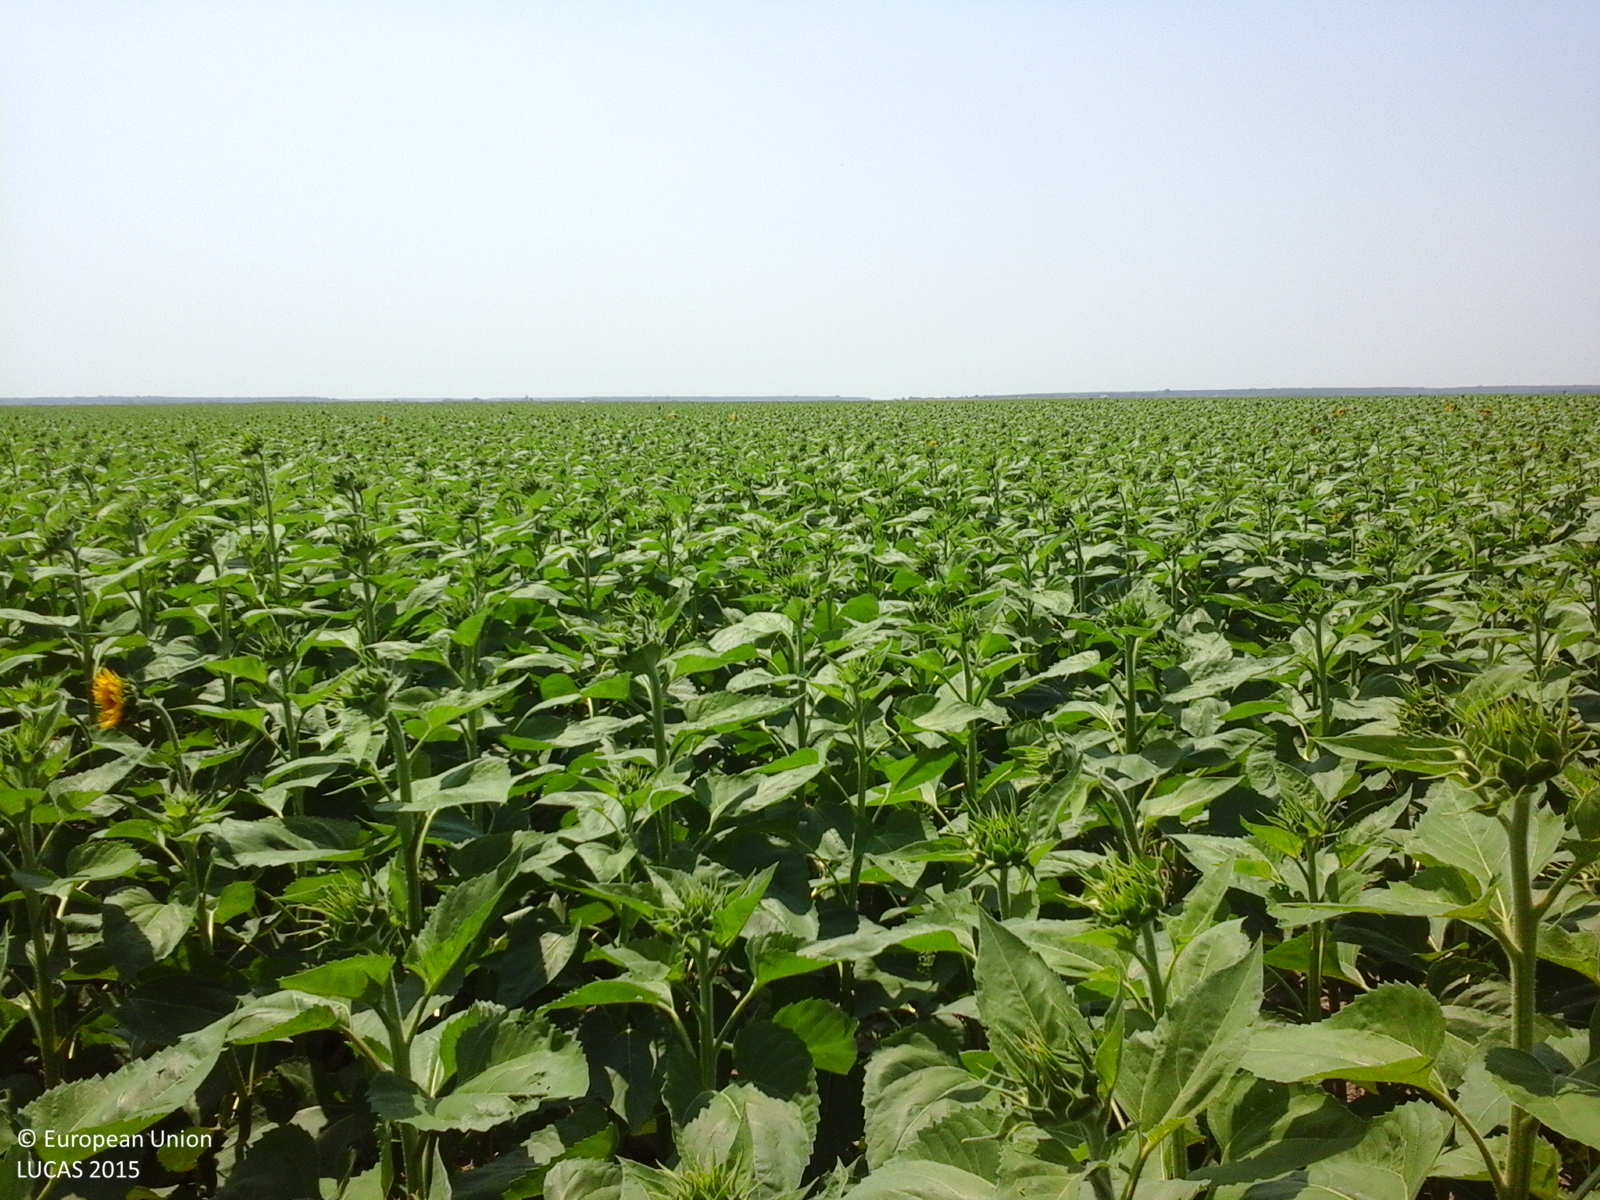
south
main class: Cropland
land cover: Sunflower
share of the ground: > 75 %
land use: Agriculture (excluding fallow land and kitchen gardens)
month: July
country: RO
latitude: 44.7569
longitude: 25.7259
